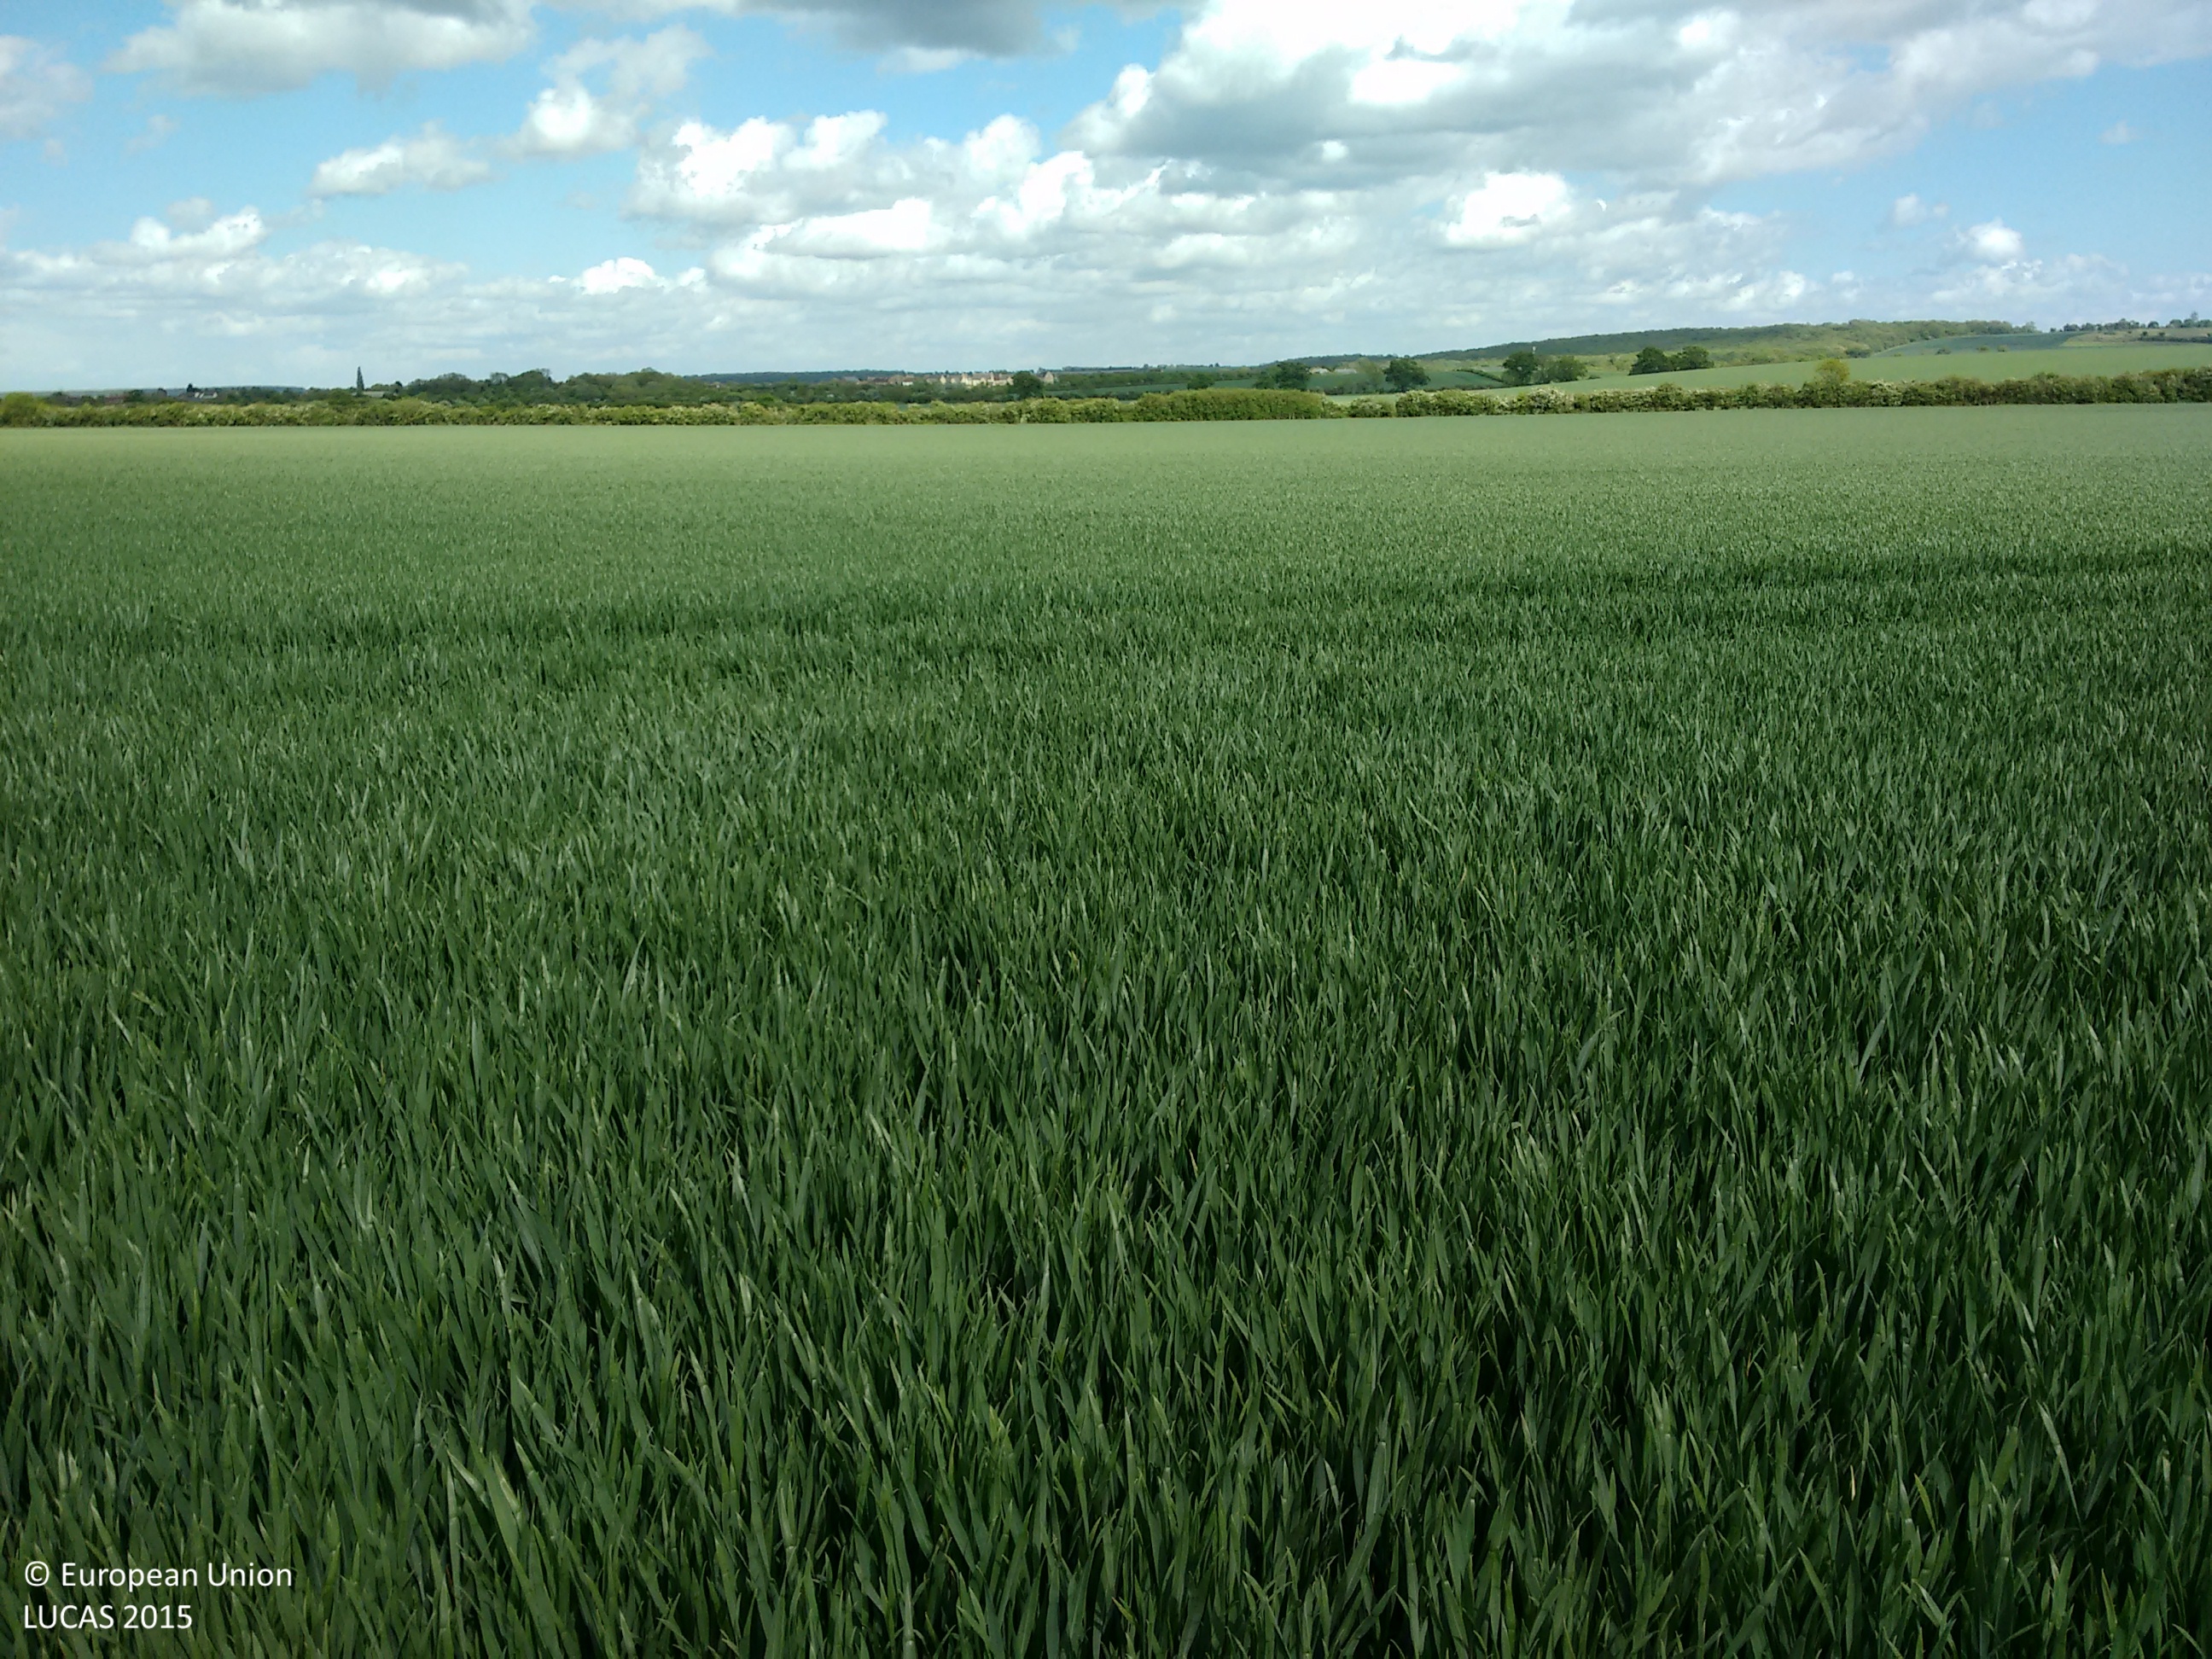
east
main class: Cropland
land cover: Common wheat
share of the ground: > 75 %
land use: Agriculture (excluding fallow land and kitchen gardens)
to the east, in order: Common wheat
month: May
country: GB
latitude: 52.0763
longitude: -0.4703
